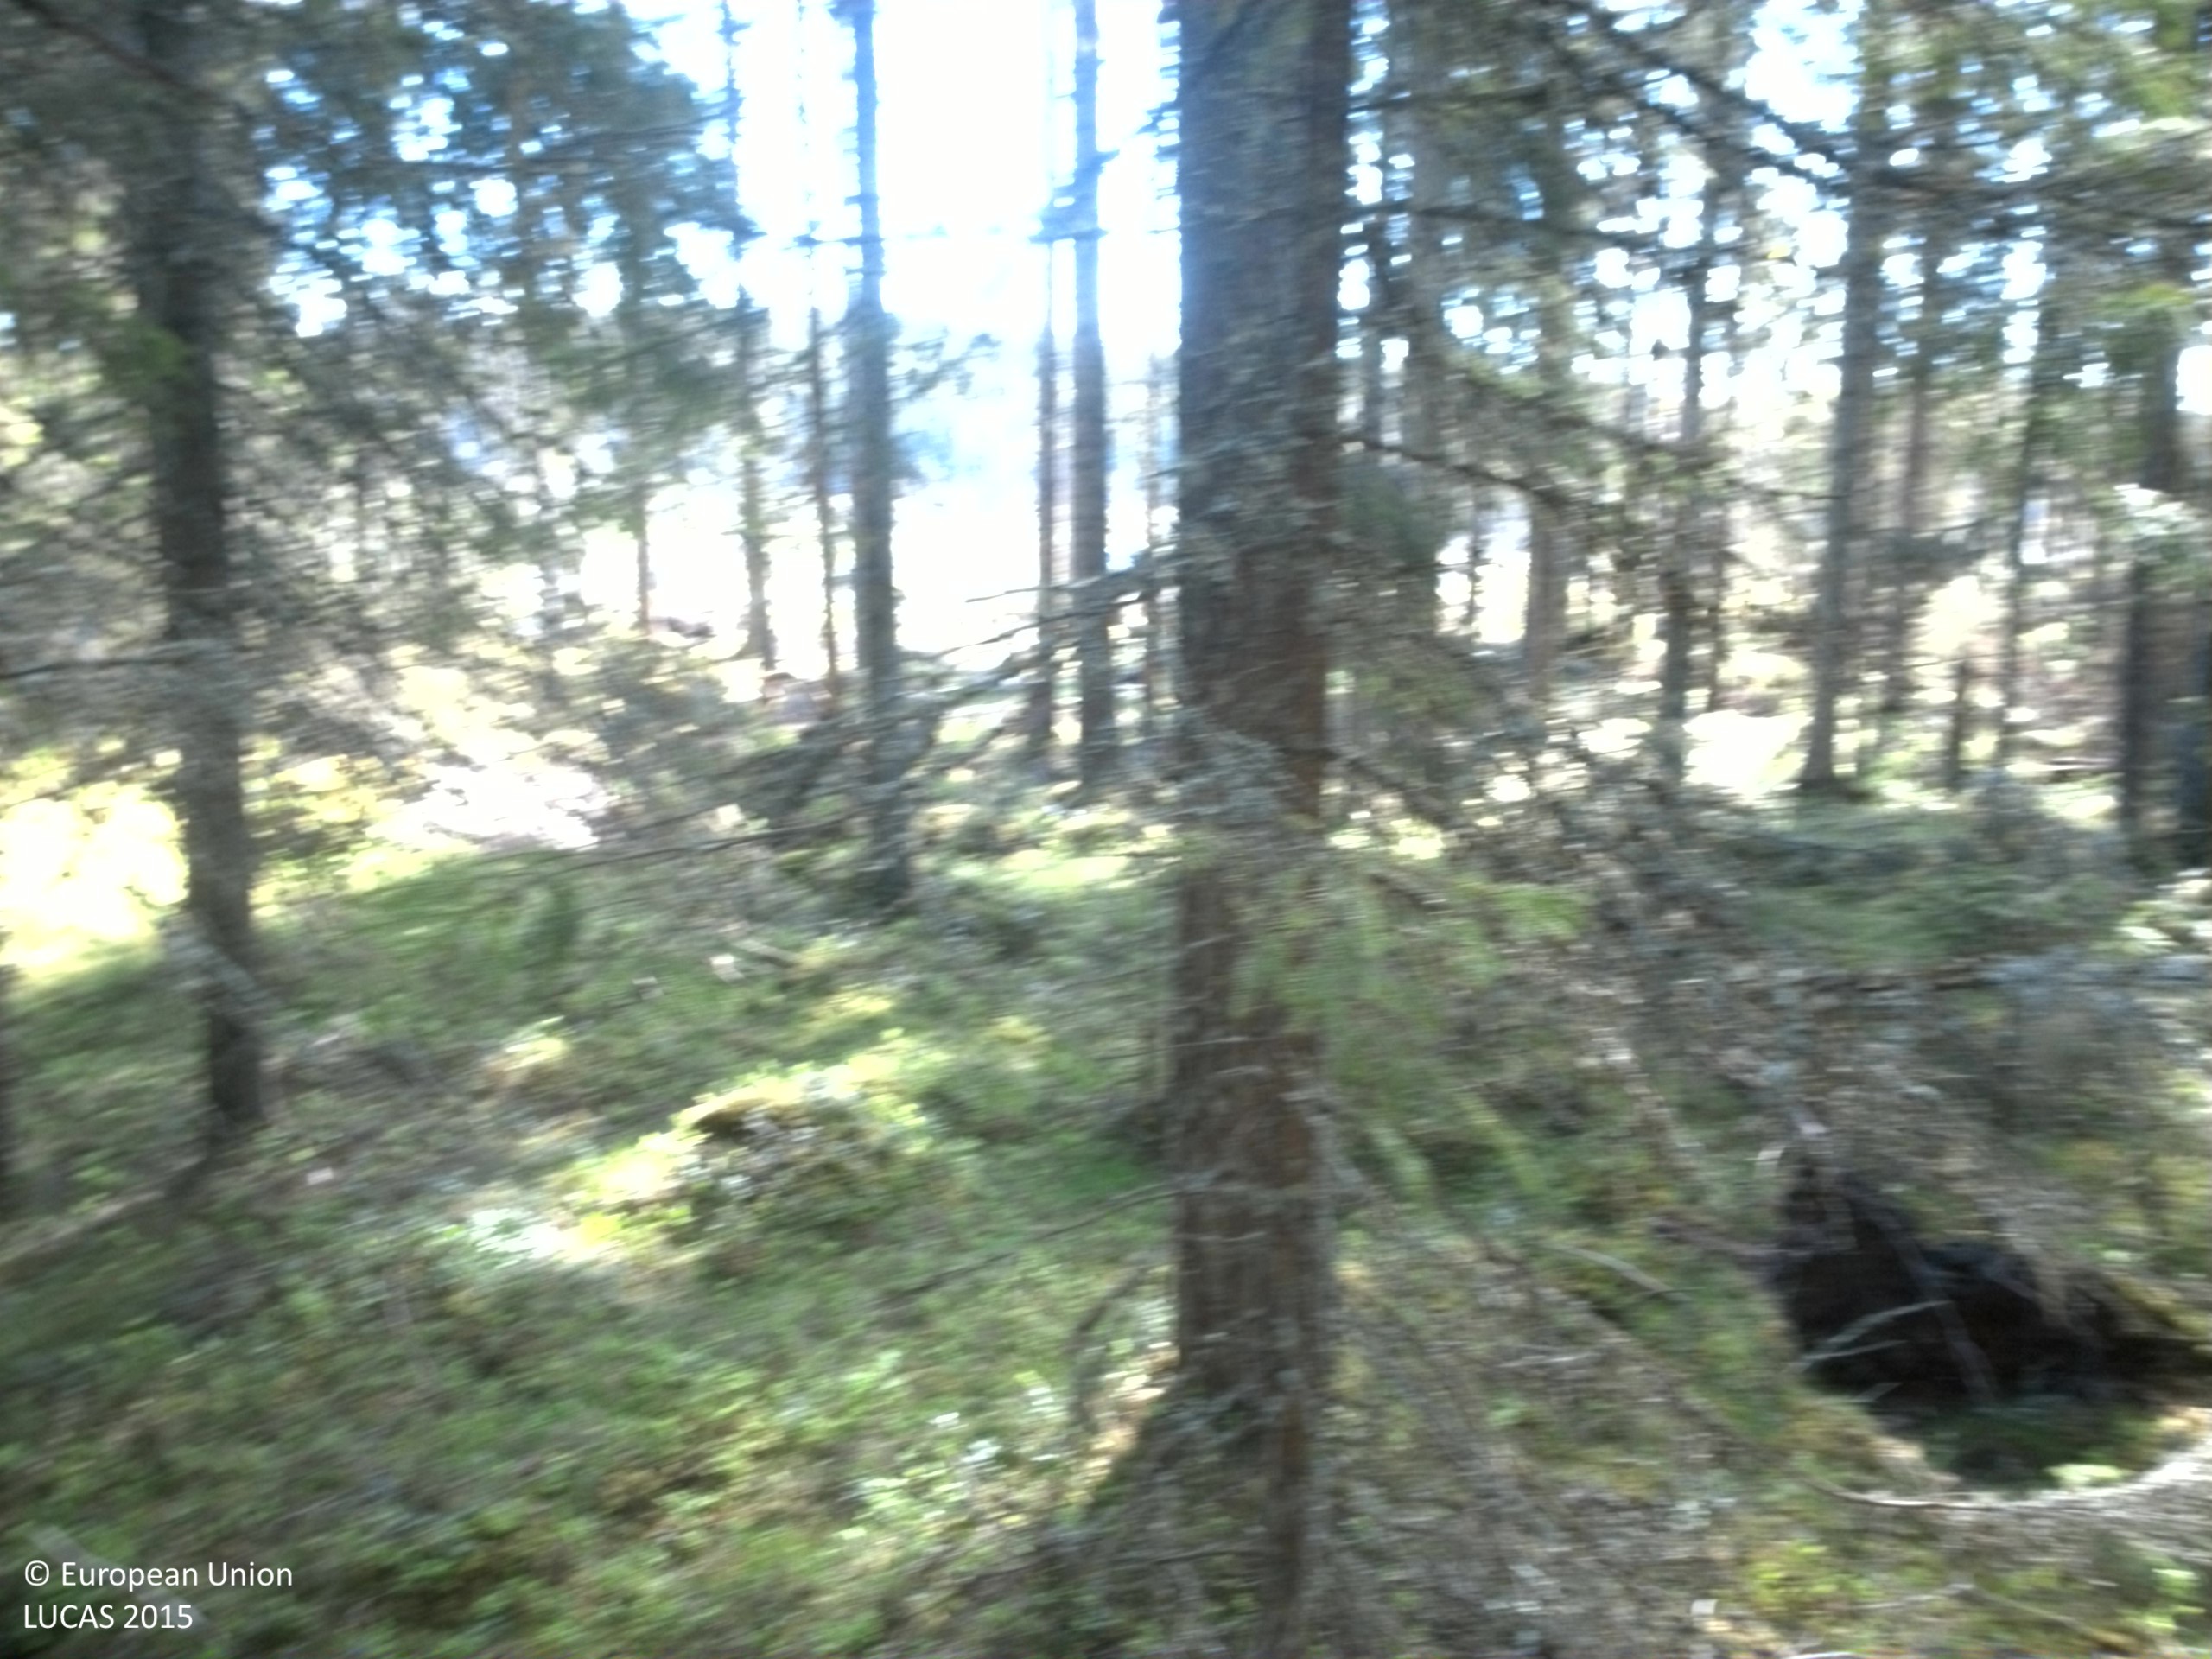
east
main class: Woodland
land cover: Spruce dominated coniferous woodland
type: boreal forest
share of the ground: > 75 %
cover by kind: coniferous forest trees 85 %, shrubs 15 %
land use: Forestry
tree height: > 5 m
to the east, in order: Spruce dominated coniferous woodland; Shrubland without tree cover; Paved roads, cycling and walking lanes; Shrubland without tree cover; Grassland with sparse tree/shrub cover
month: May
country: SE
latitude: 62.8219
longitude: 18.2417
